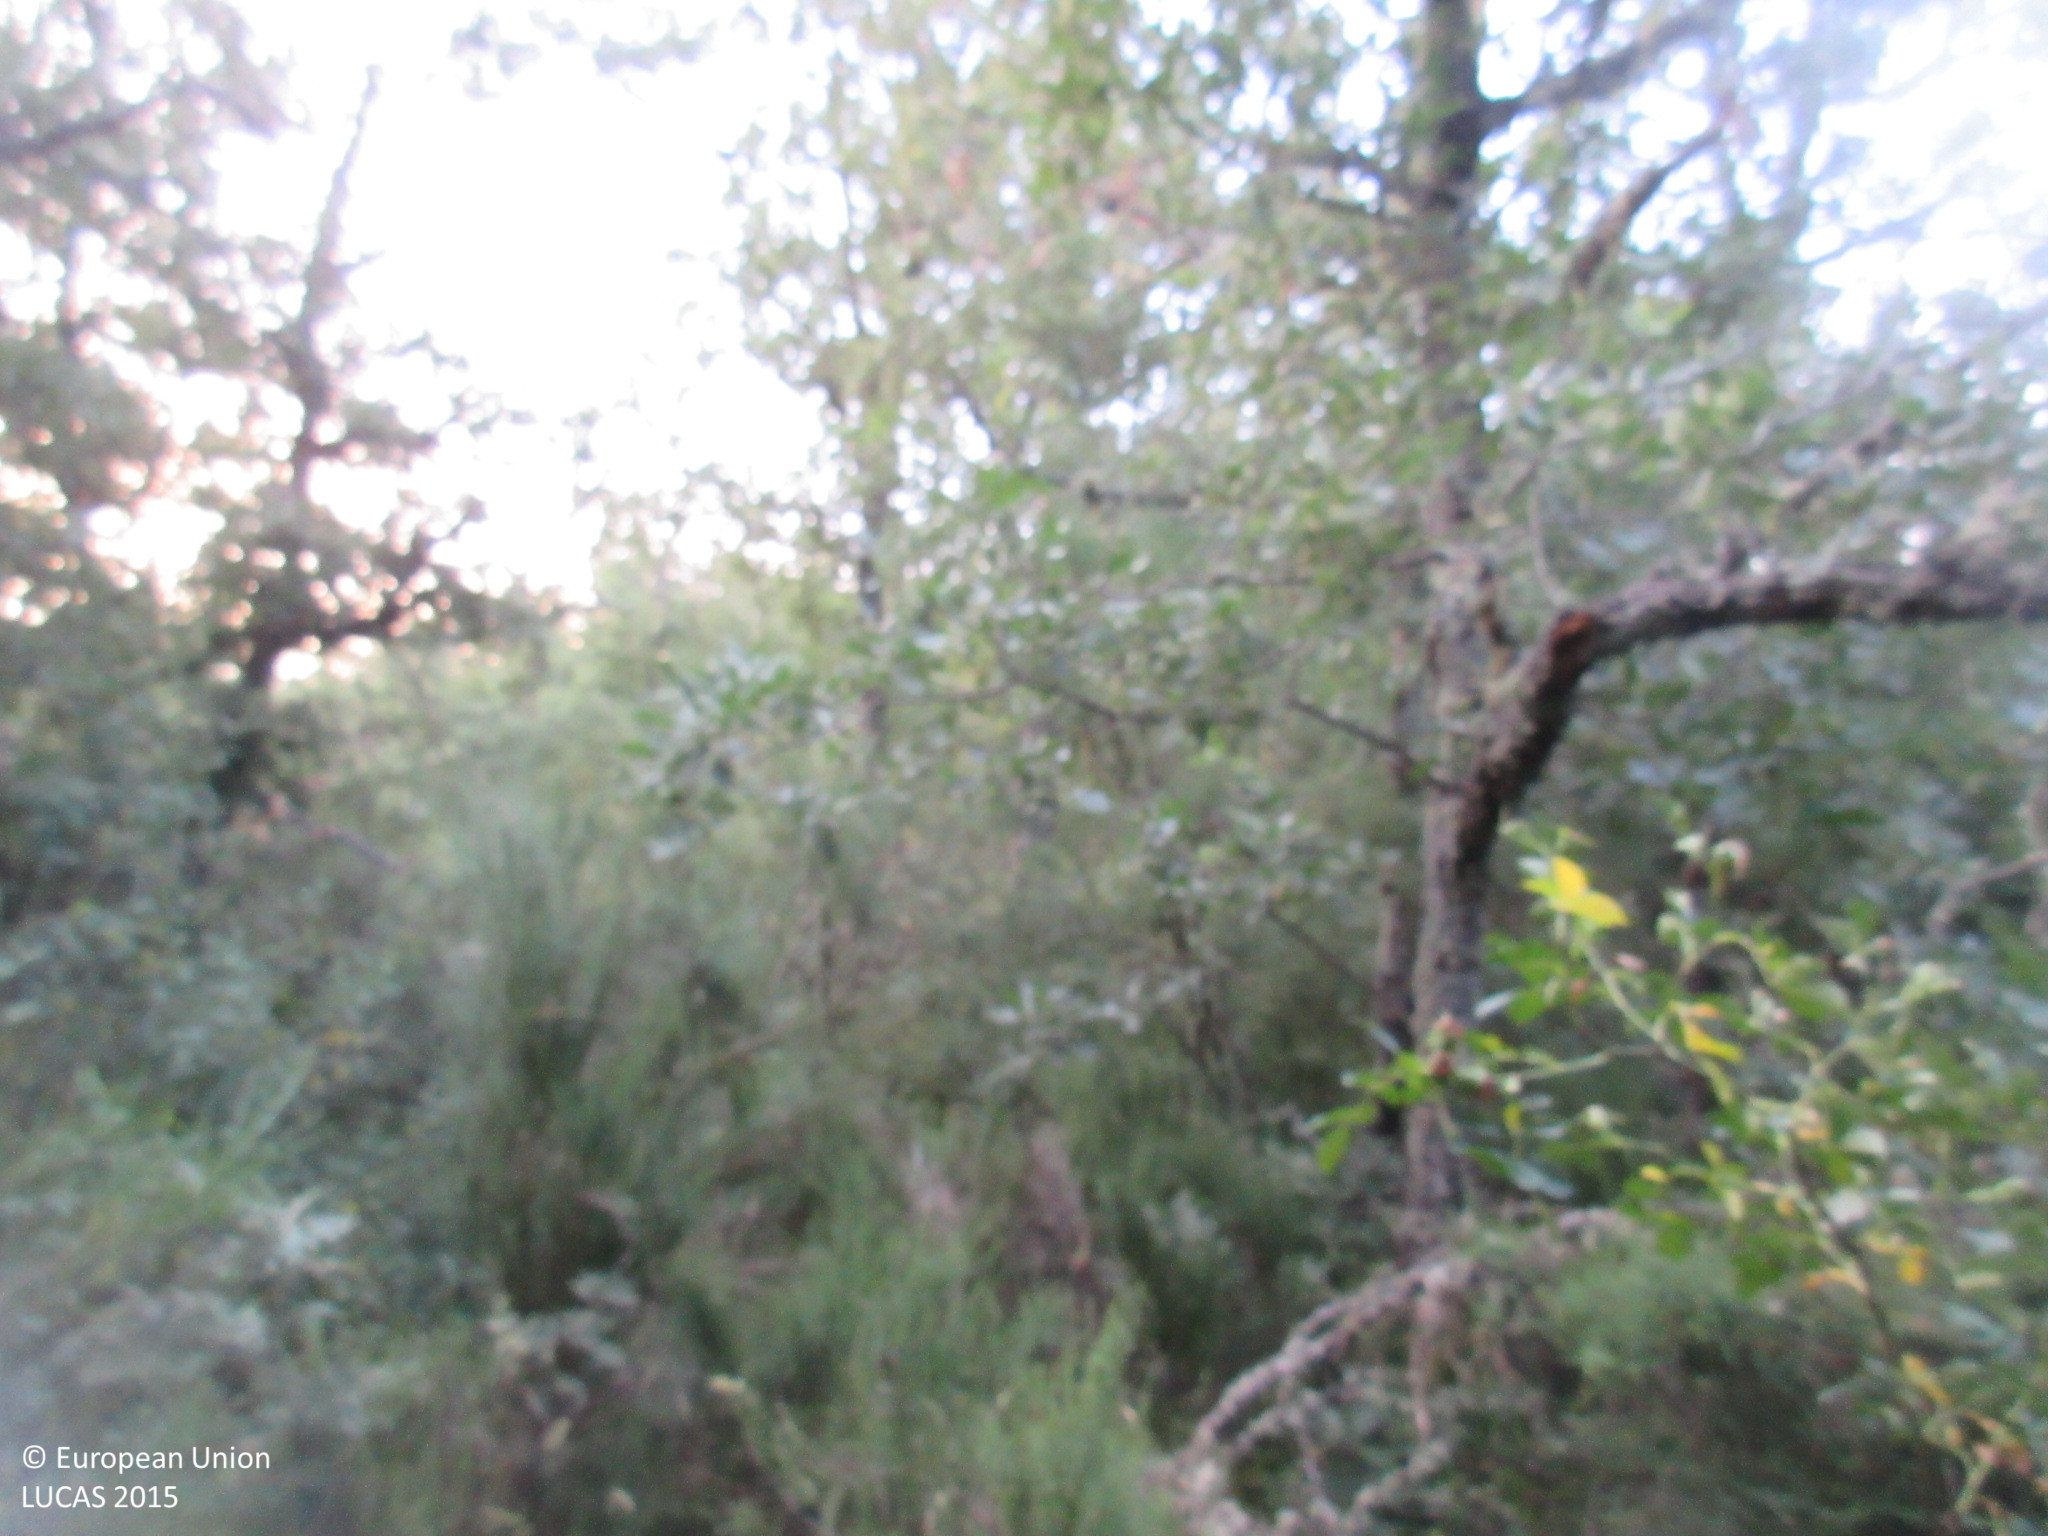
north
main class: Woodland
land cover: Broadleaved woodland
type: acidophilous oak and oak-birch forest
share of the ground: > 75 %
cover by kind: broadleaved forest trees 90 %, shrubs 10 %
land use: Semi-natural and natural areas not in use
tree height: > 5 m
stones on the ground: 10 - 25 %
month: July
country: ES
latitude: 42.8769
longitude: -4.4388
